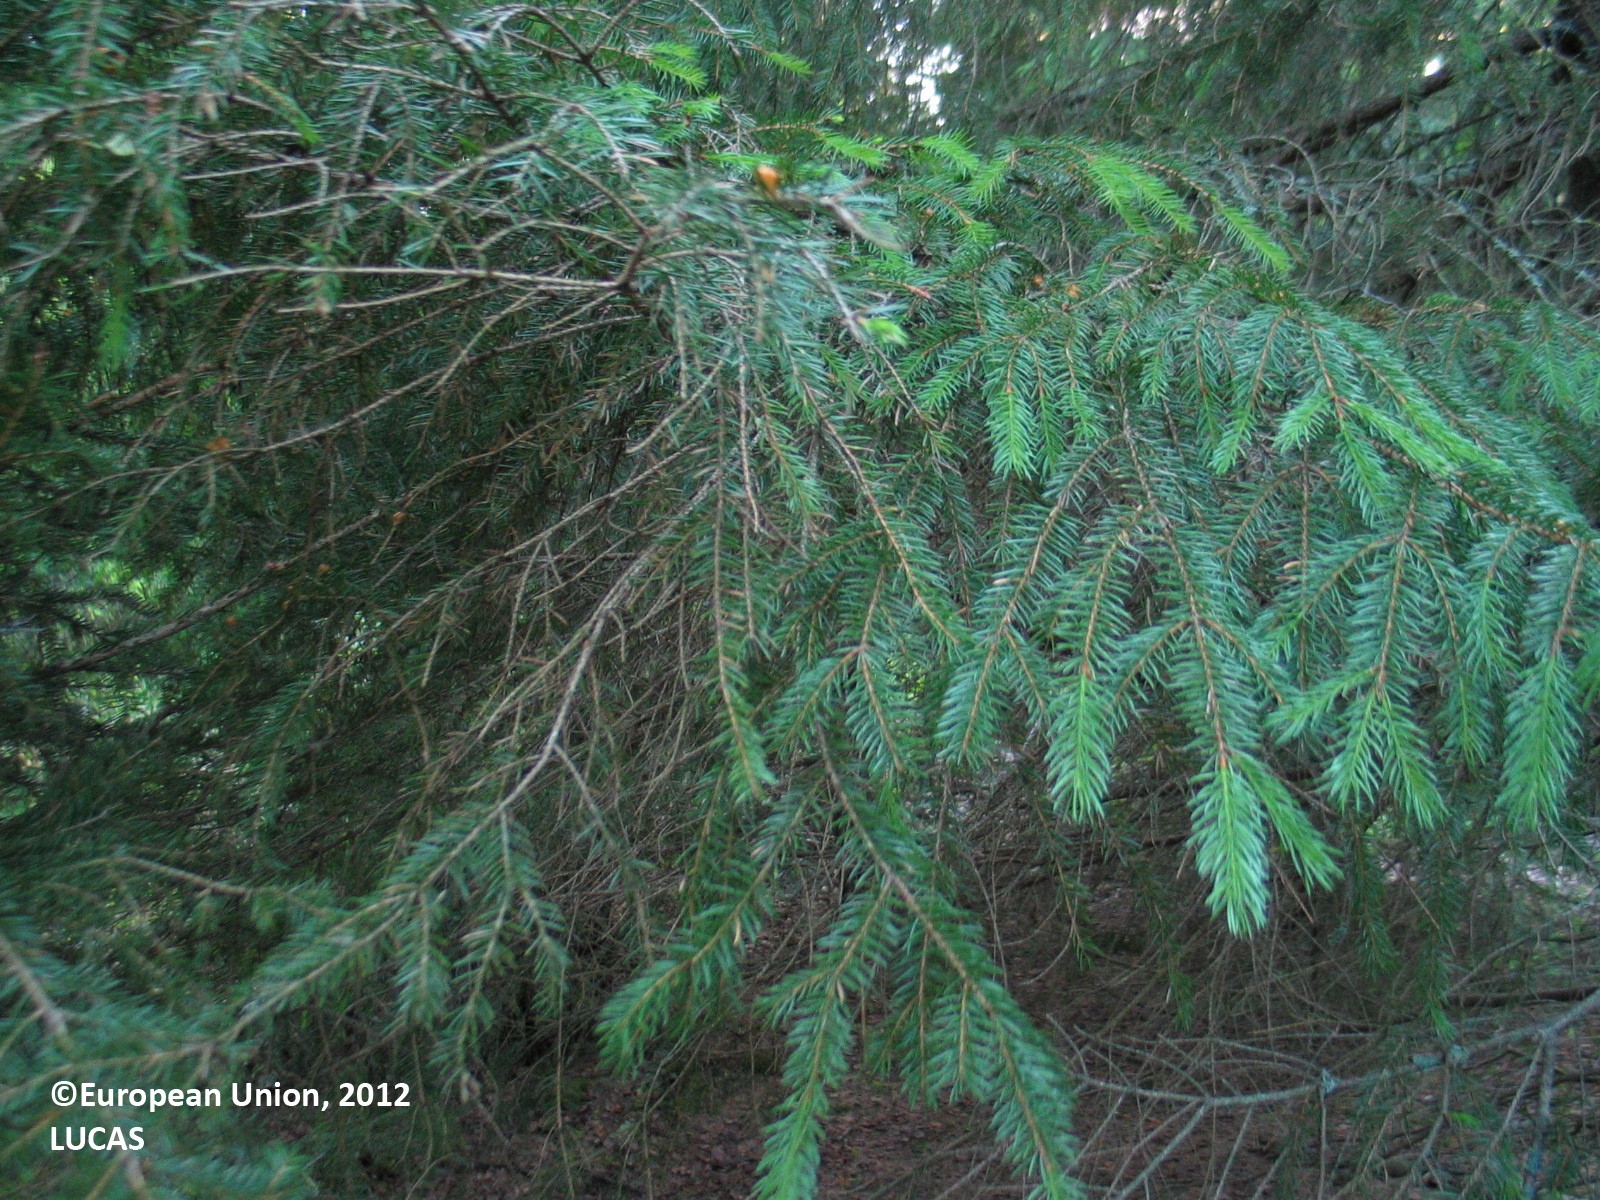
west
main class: Woodland
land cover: Spruce dominated coniferous woodland
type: boreal forest
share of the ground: 50 - 75 %
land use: Forestry
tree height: > 5 m
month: June
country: FI
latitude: 65.1290
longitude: 25.4886
